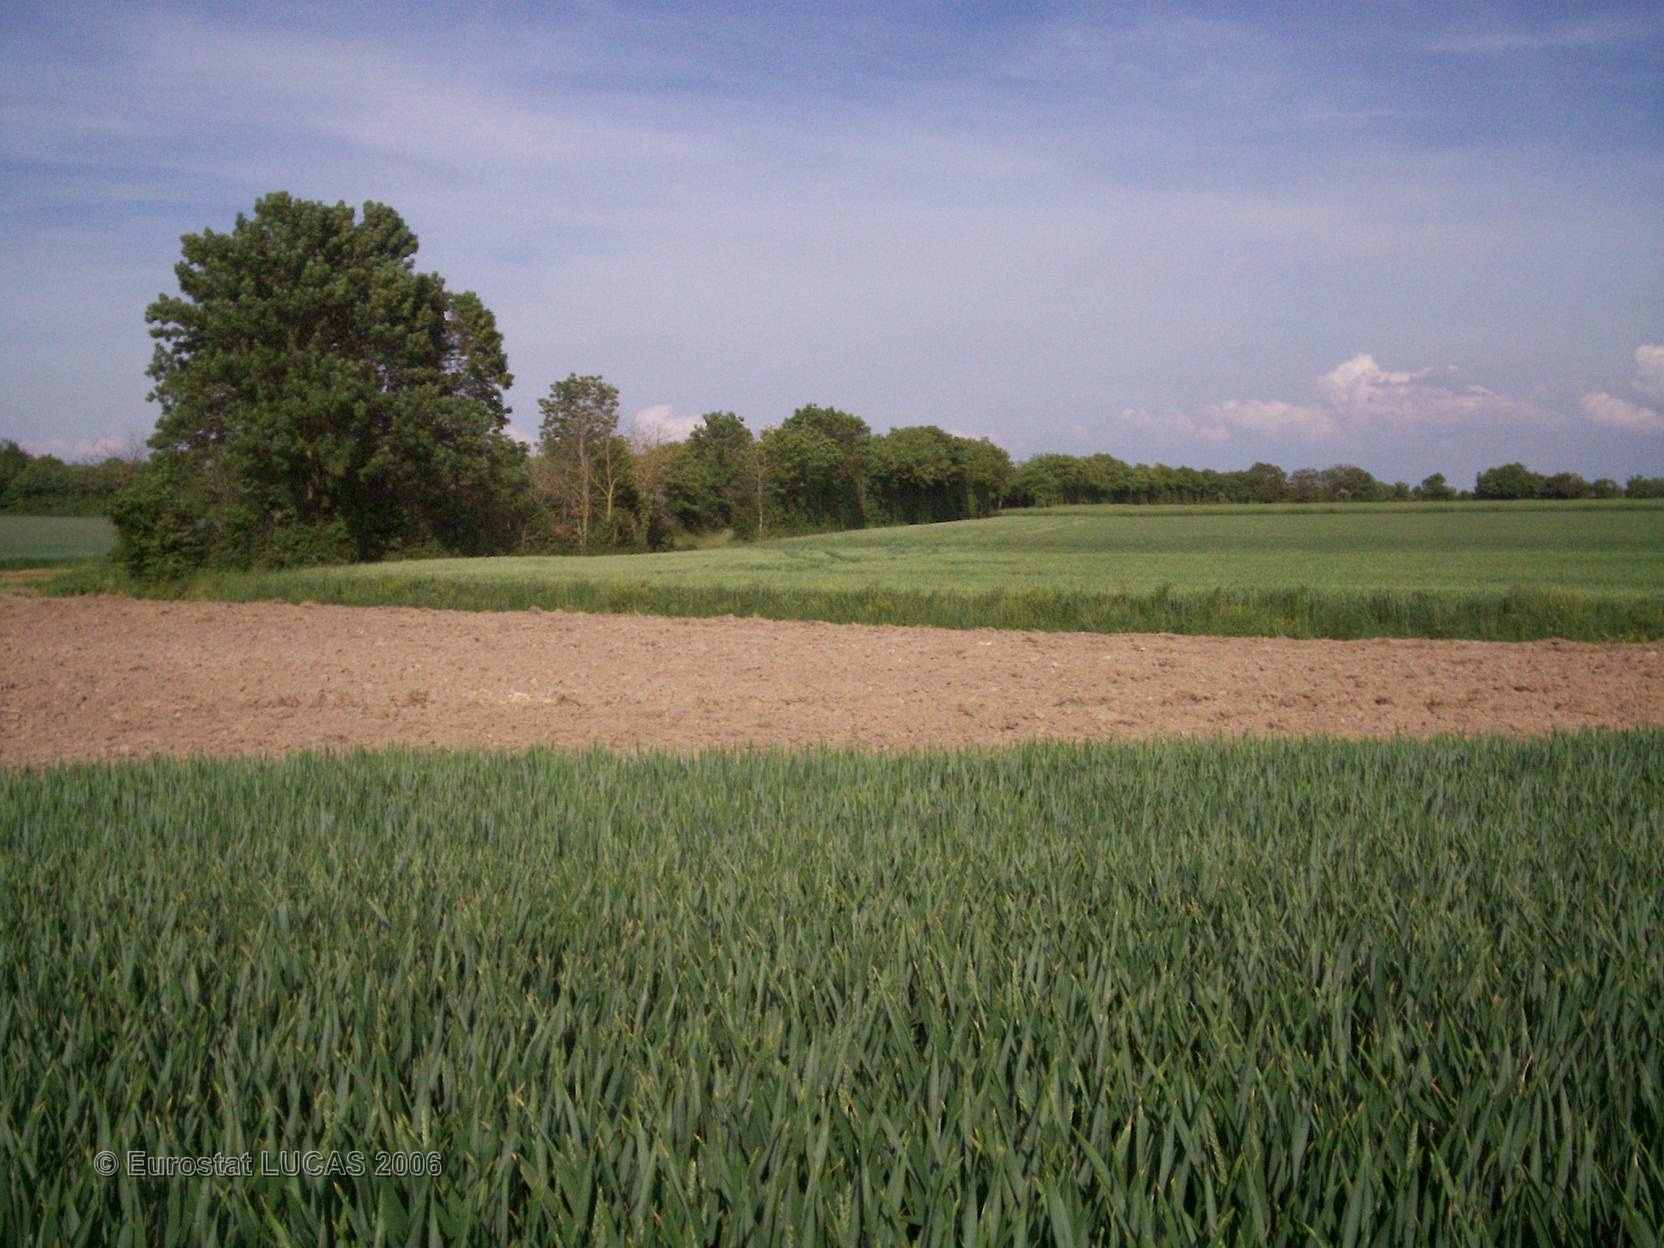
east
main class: Cropland
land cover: Common wheat
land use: Agriculture (excluding fallow land and kitchen gardens)
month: May
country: FR
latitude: 46.1184
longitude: -0.1796
